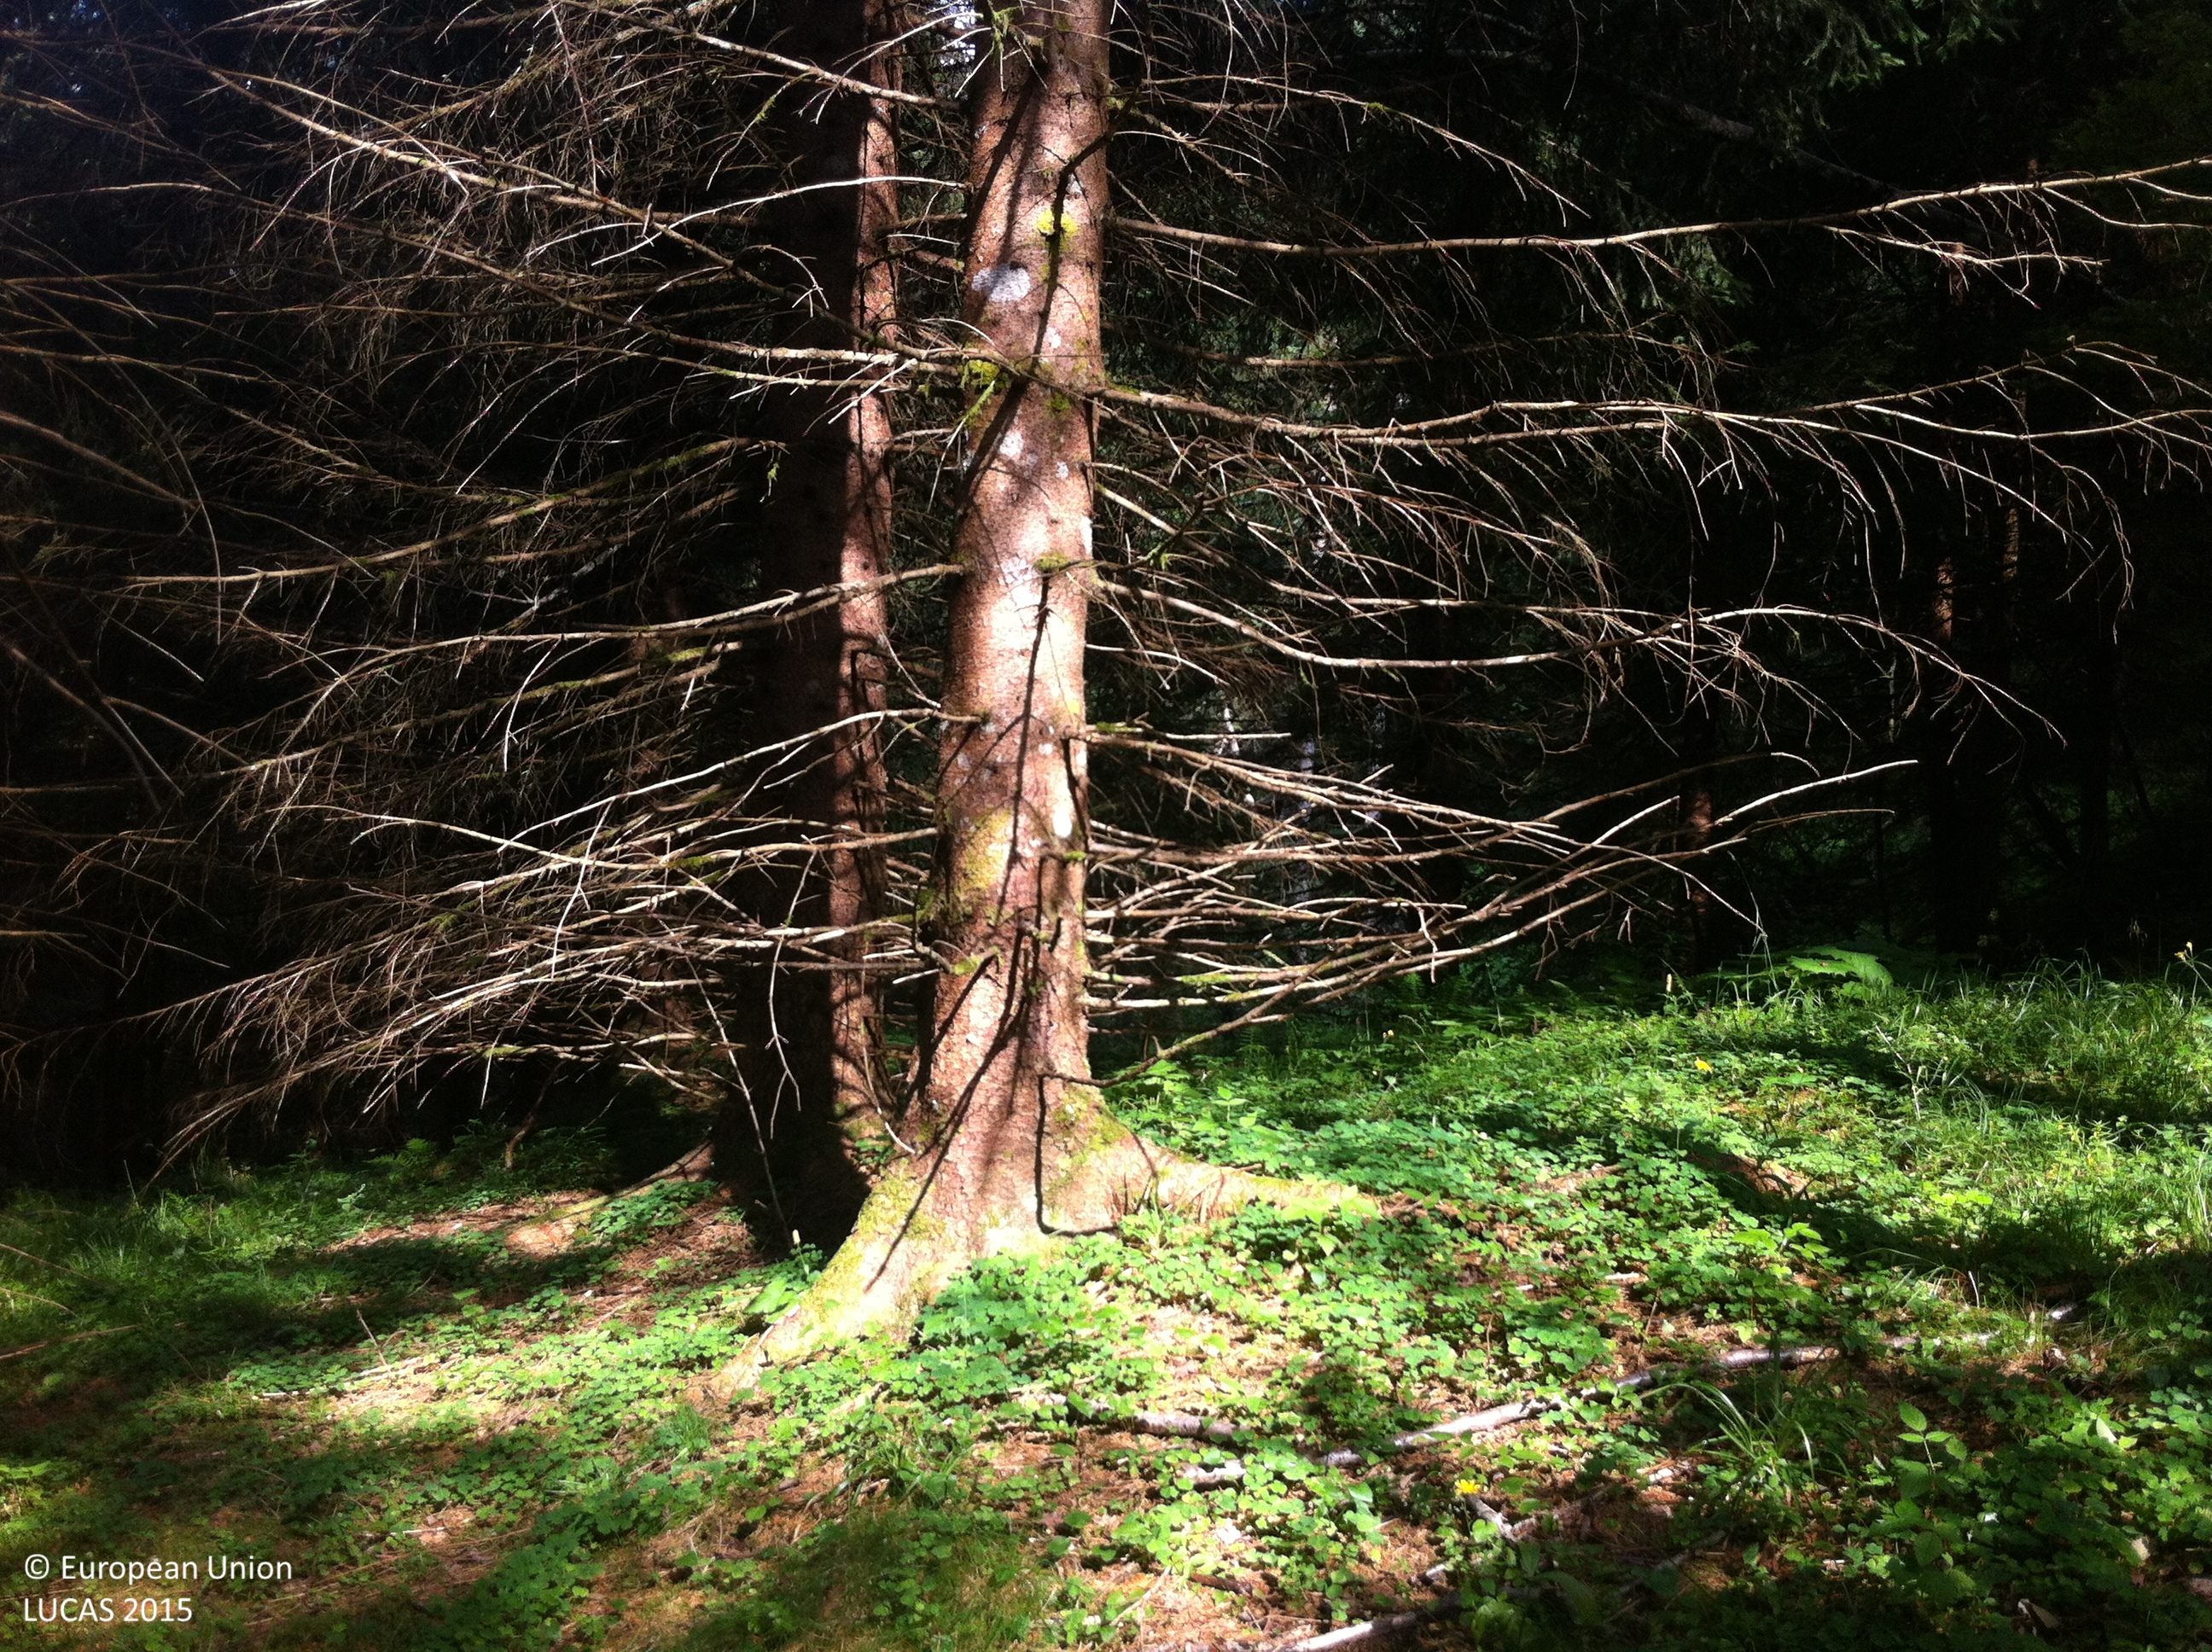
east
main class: Woodland
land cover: Spruce dominated coniferous woodland
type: alpine coniferous forest
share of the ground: > 75 %
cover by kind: coniferous forest trees 85 %, broadleaved forest trees 5 %, shrubs 5 %, herbaceous plants 5 %
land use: Forestry
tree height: > 5 m
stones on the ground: < 10 %
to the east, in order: Spruce dominated coniferous woodland; Rivers and streams; Spruce dominated coniferous woodland; Spruce dominated mixed woodland; Grassland without tree/shrub cover; Inland marshes; Shruby margins; Tracks; Spruce dominated coniferous woodland; Spruce dominated mixed woodland
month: July
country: AT
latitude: 47.1255
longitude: 10.0395
